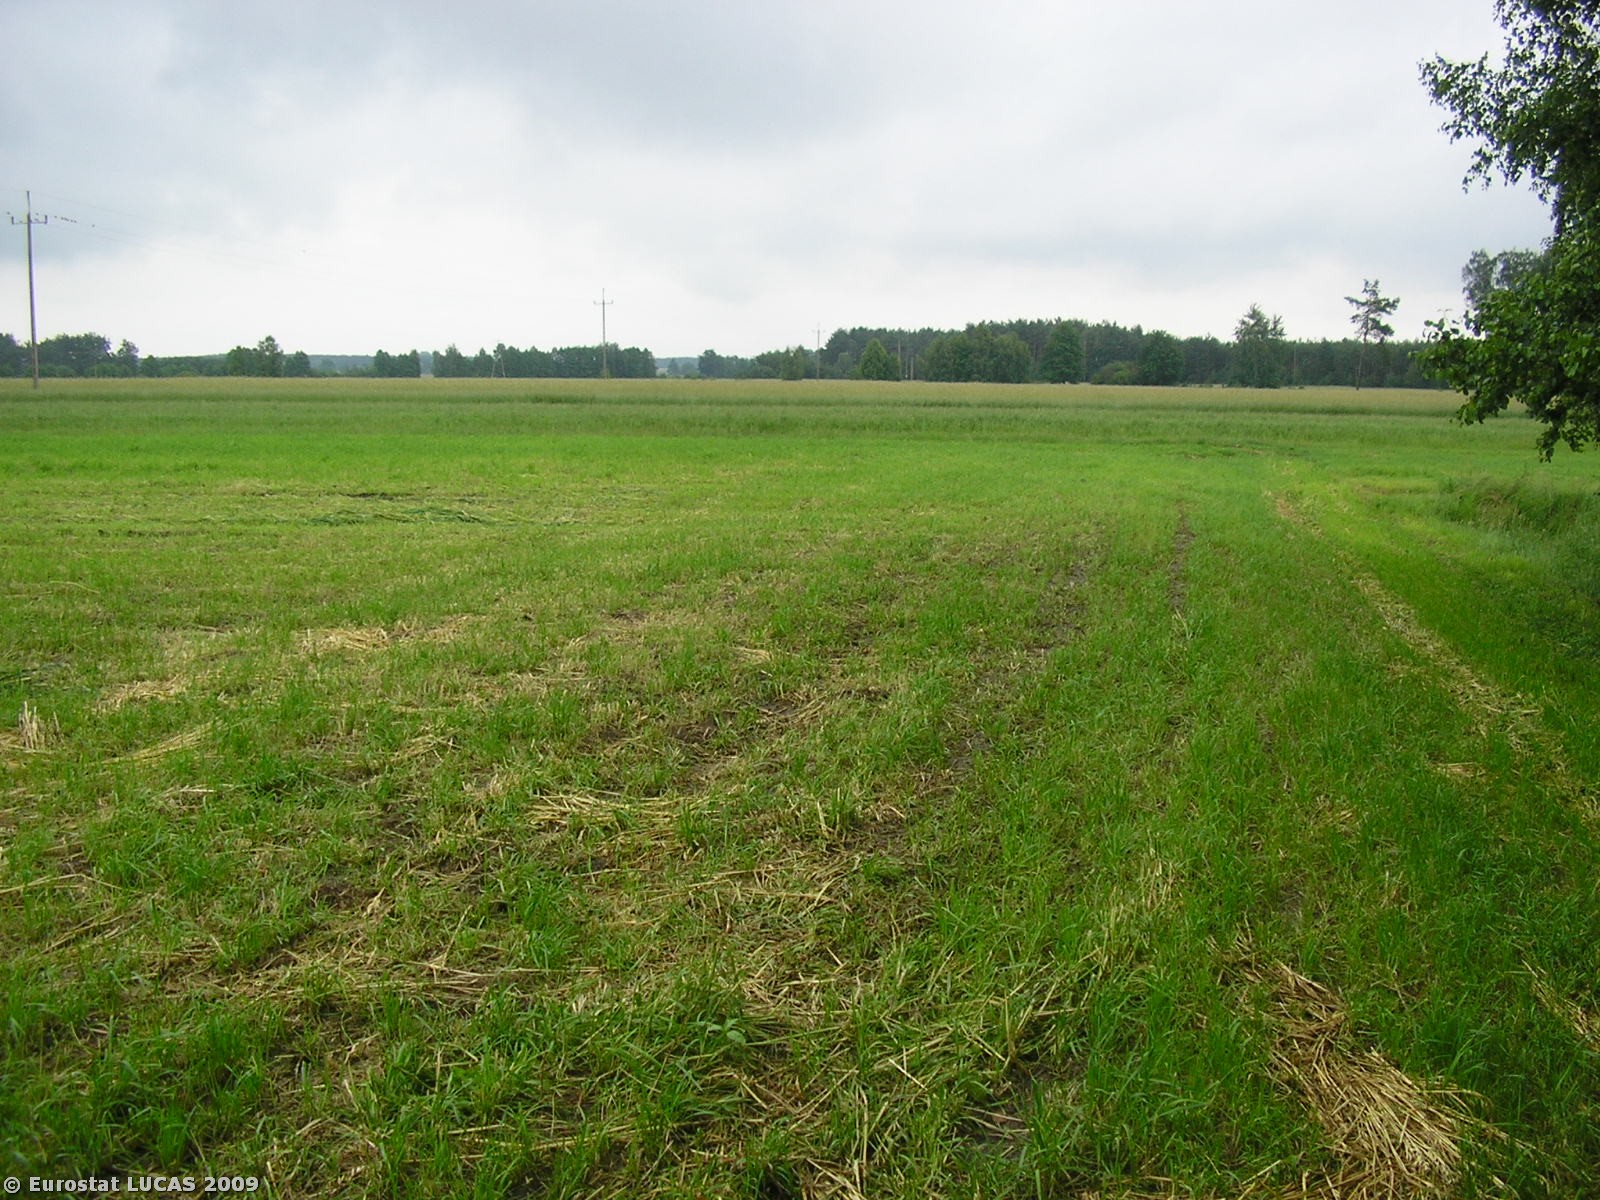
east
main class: Grassland
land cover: Grassland without tree/shrub cover
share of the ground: > 75 %
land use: Agriculture (excluding fallow land and kitchen gardens)
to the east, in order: Grassland without tree/shrub cover; Tracks; Grassland without tree/shrub cover; Rye; Tracks; Rye; Grass margins; Oats; Tracks; Triticale; Electric lines; Triticale
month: June
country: PL
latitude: 51.3529
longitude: 18.4479
